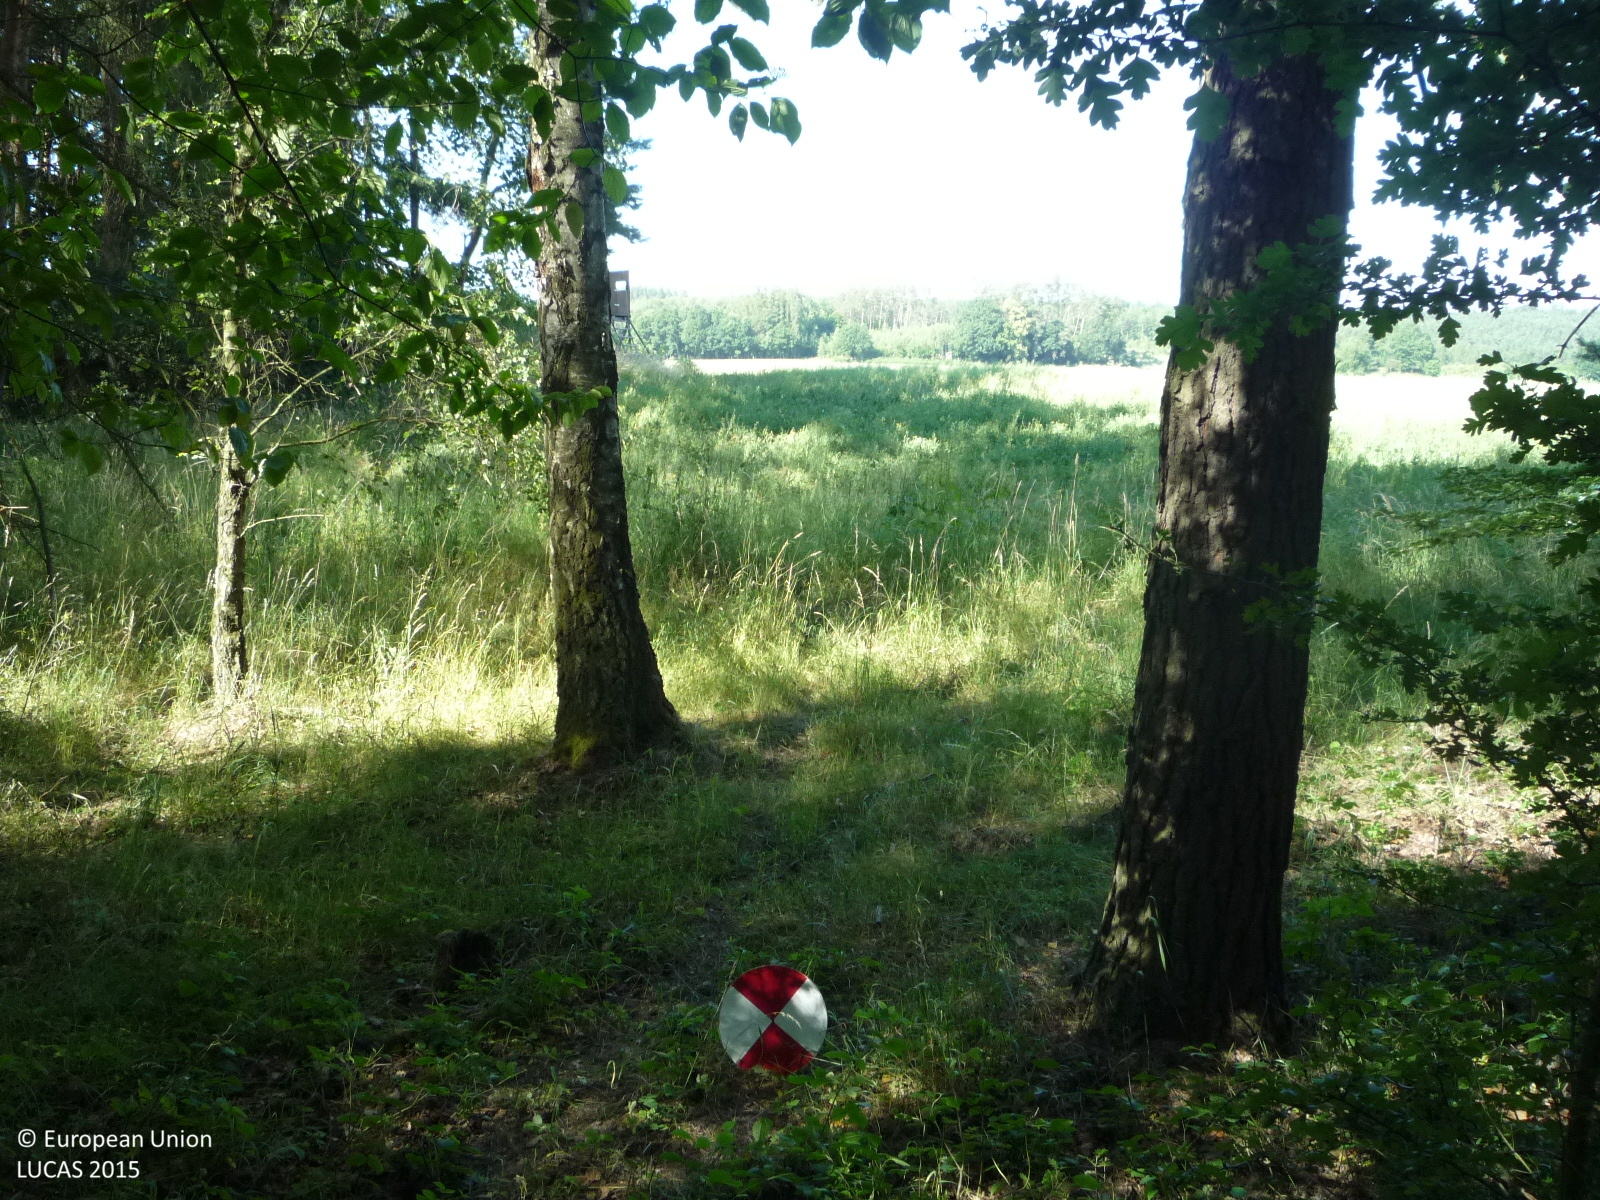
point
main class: Woodland
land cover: Other mixed woodland
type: hemiboreal forest and nemoral coniferous forest and mixed broadleaved-coniferous forest
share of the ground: > 75 %
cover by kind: broadleaved forest trees 50 %, coniferous forest trees 45 %, herbaceous plants 5 %
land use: Forestry
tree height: > 5 m
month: July
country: CZ
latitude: 50.4928
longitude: 14.4702
